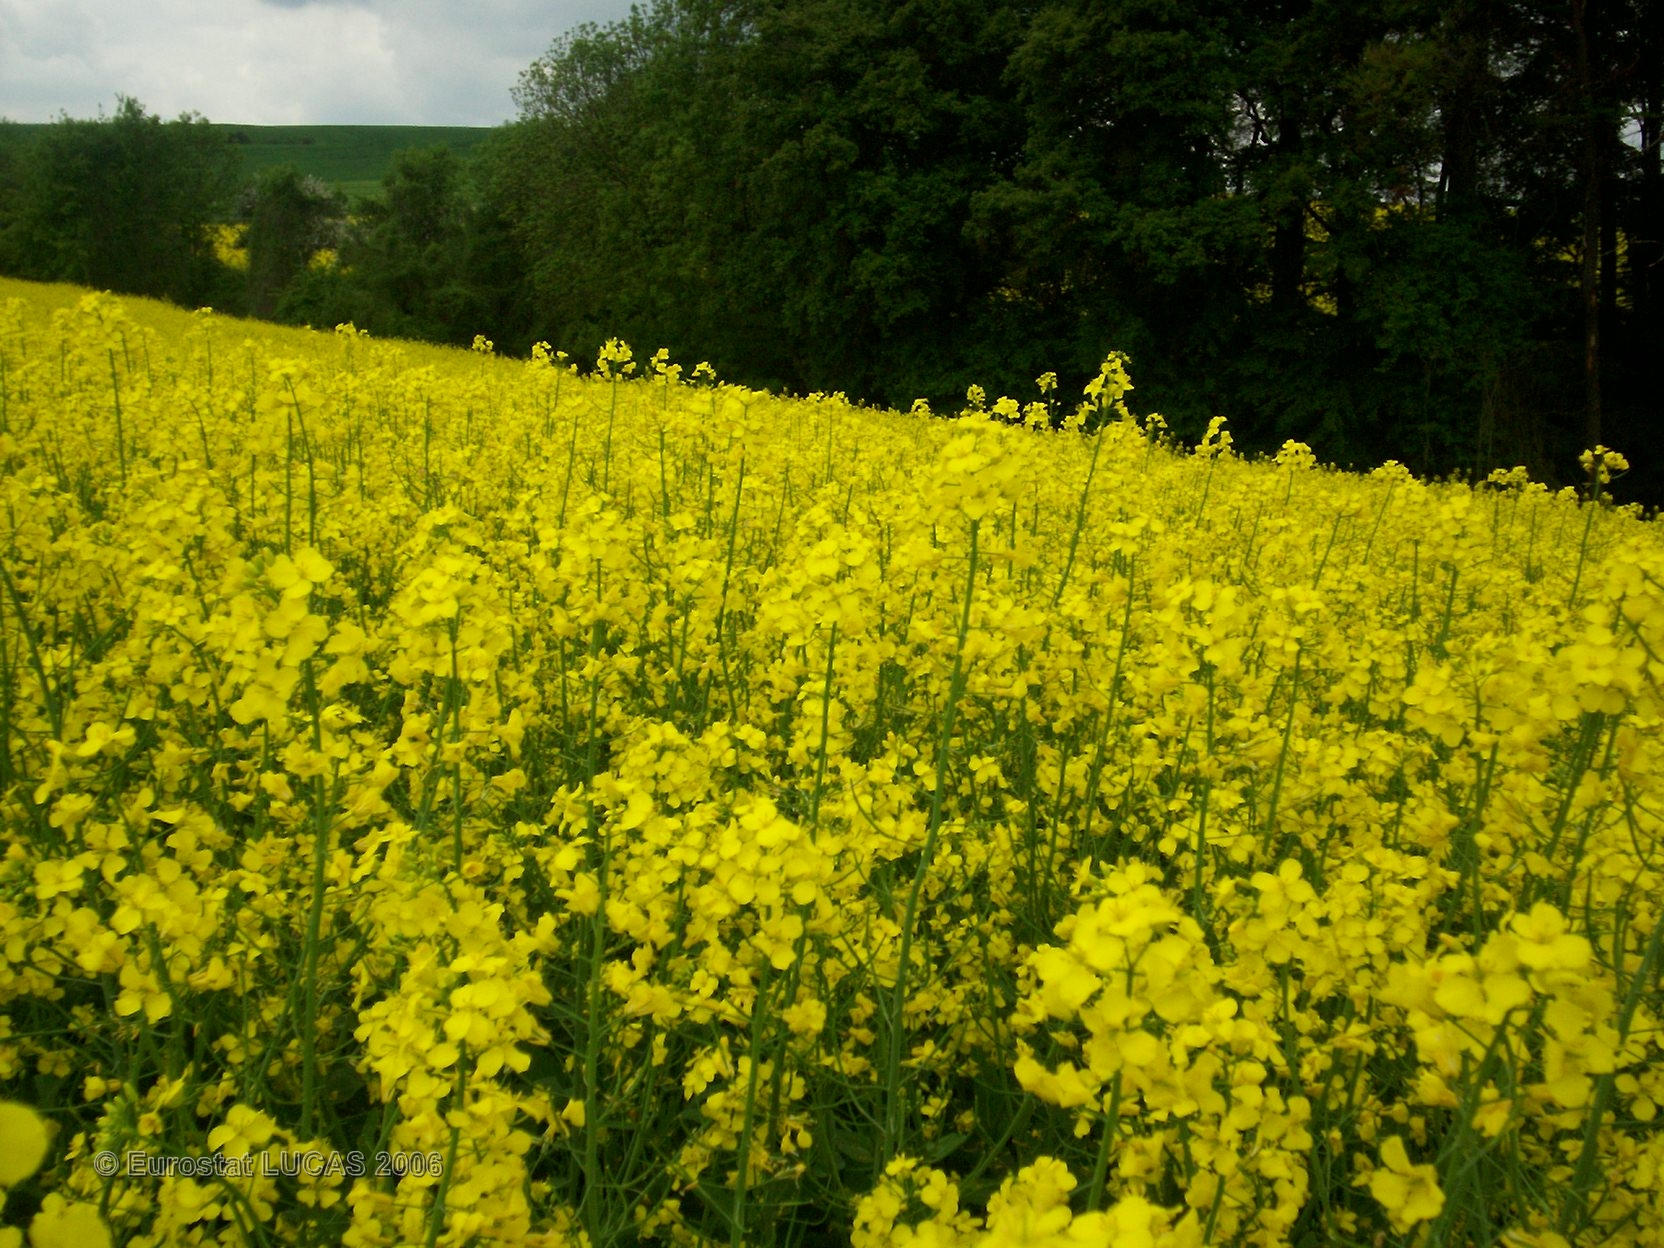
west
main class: Cropland
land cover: Rape and turnip rape
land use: Agriculture (excluding fallow land and kitchen gardens)
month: May
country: FR
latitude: 49.4074
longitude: 6.4027
